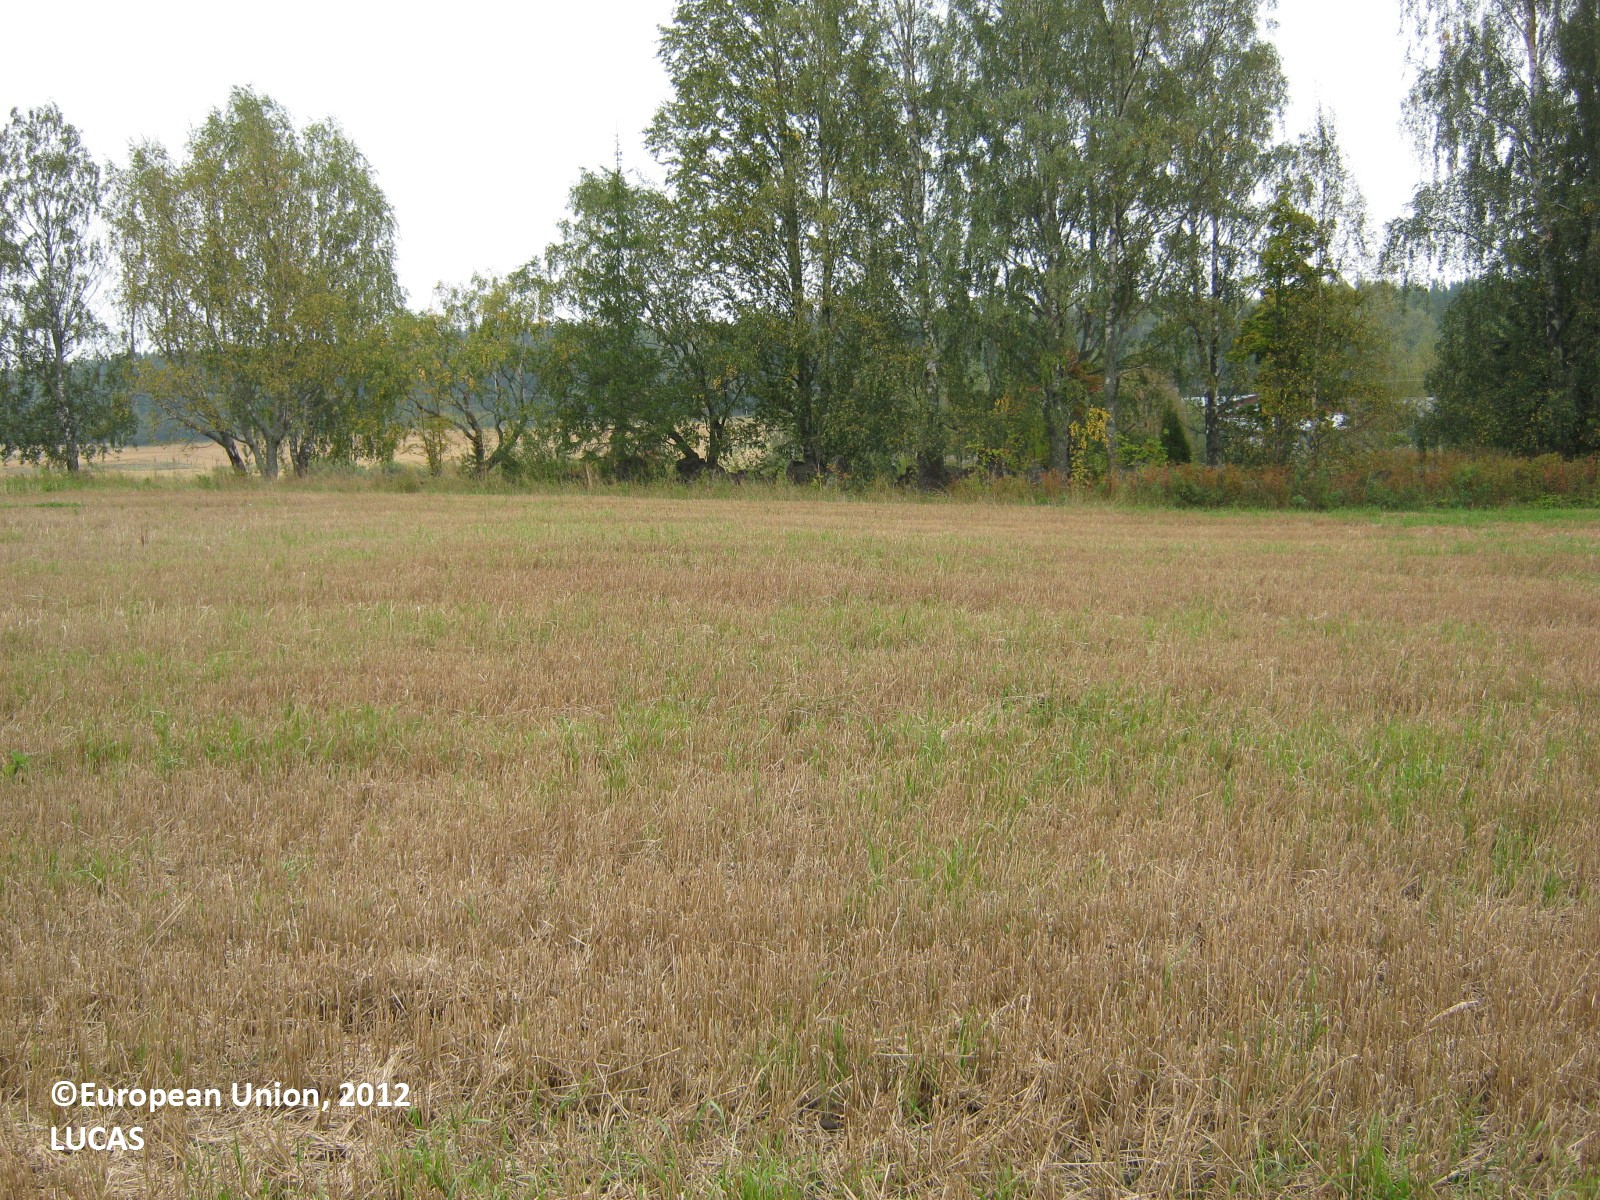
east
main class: Cropland
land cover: Barley
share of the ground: 50 - 75 %
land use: Agriculture (excluding fallow land and kitchen gardens)
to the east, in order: Barley; Grass margins; Ditches and canals; Broadleaved woodland; Ditches and canals; Tracks; Grass margins; Ditches and canals; Grass margins; Oats; Electric lines; Oats; Grass margins; Shrubland without tree cover; Inland running water; Spontaneously vegetated surfaces; Oats
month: September
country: FI
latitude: 60.5289
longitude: 27.5534
